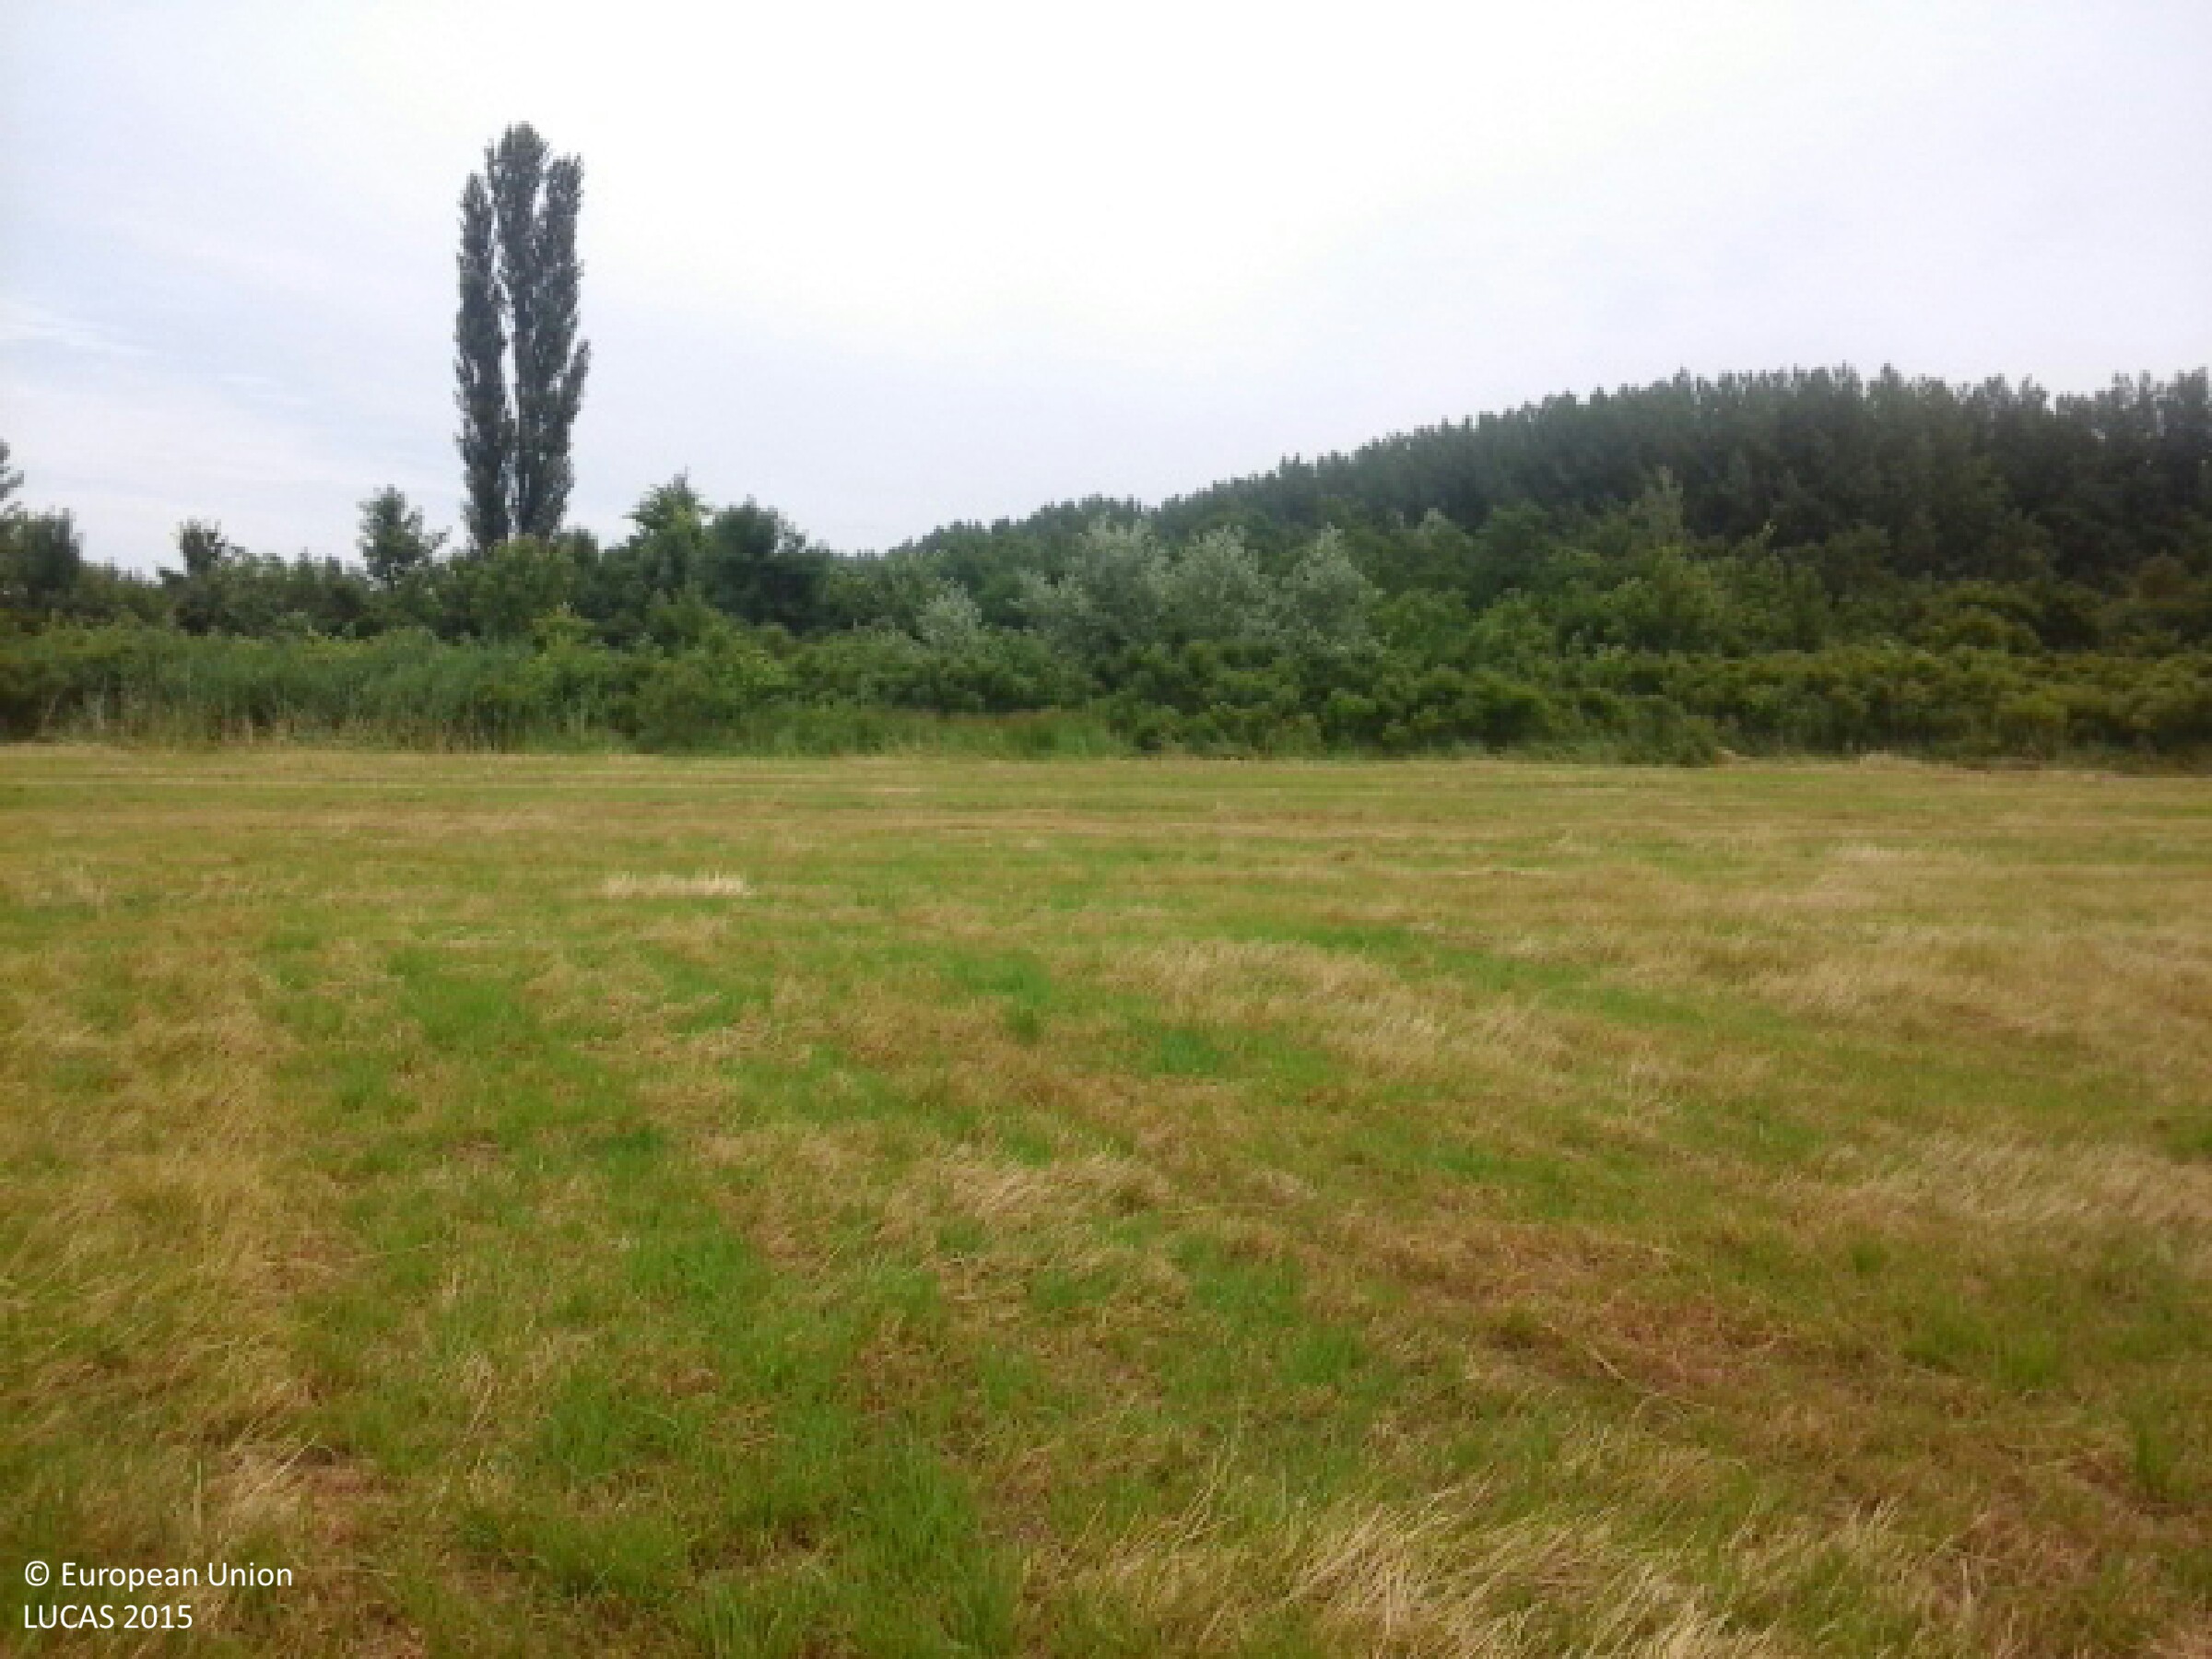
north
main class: Grassland
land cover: Grassland without tree/shrub cover
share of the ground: > 75 %
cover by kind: herbaceous plants 100 %
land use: Abandoned areas
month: June
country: HU
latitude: 48.1349
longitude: 21.7805
